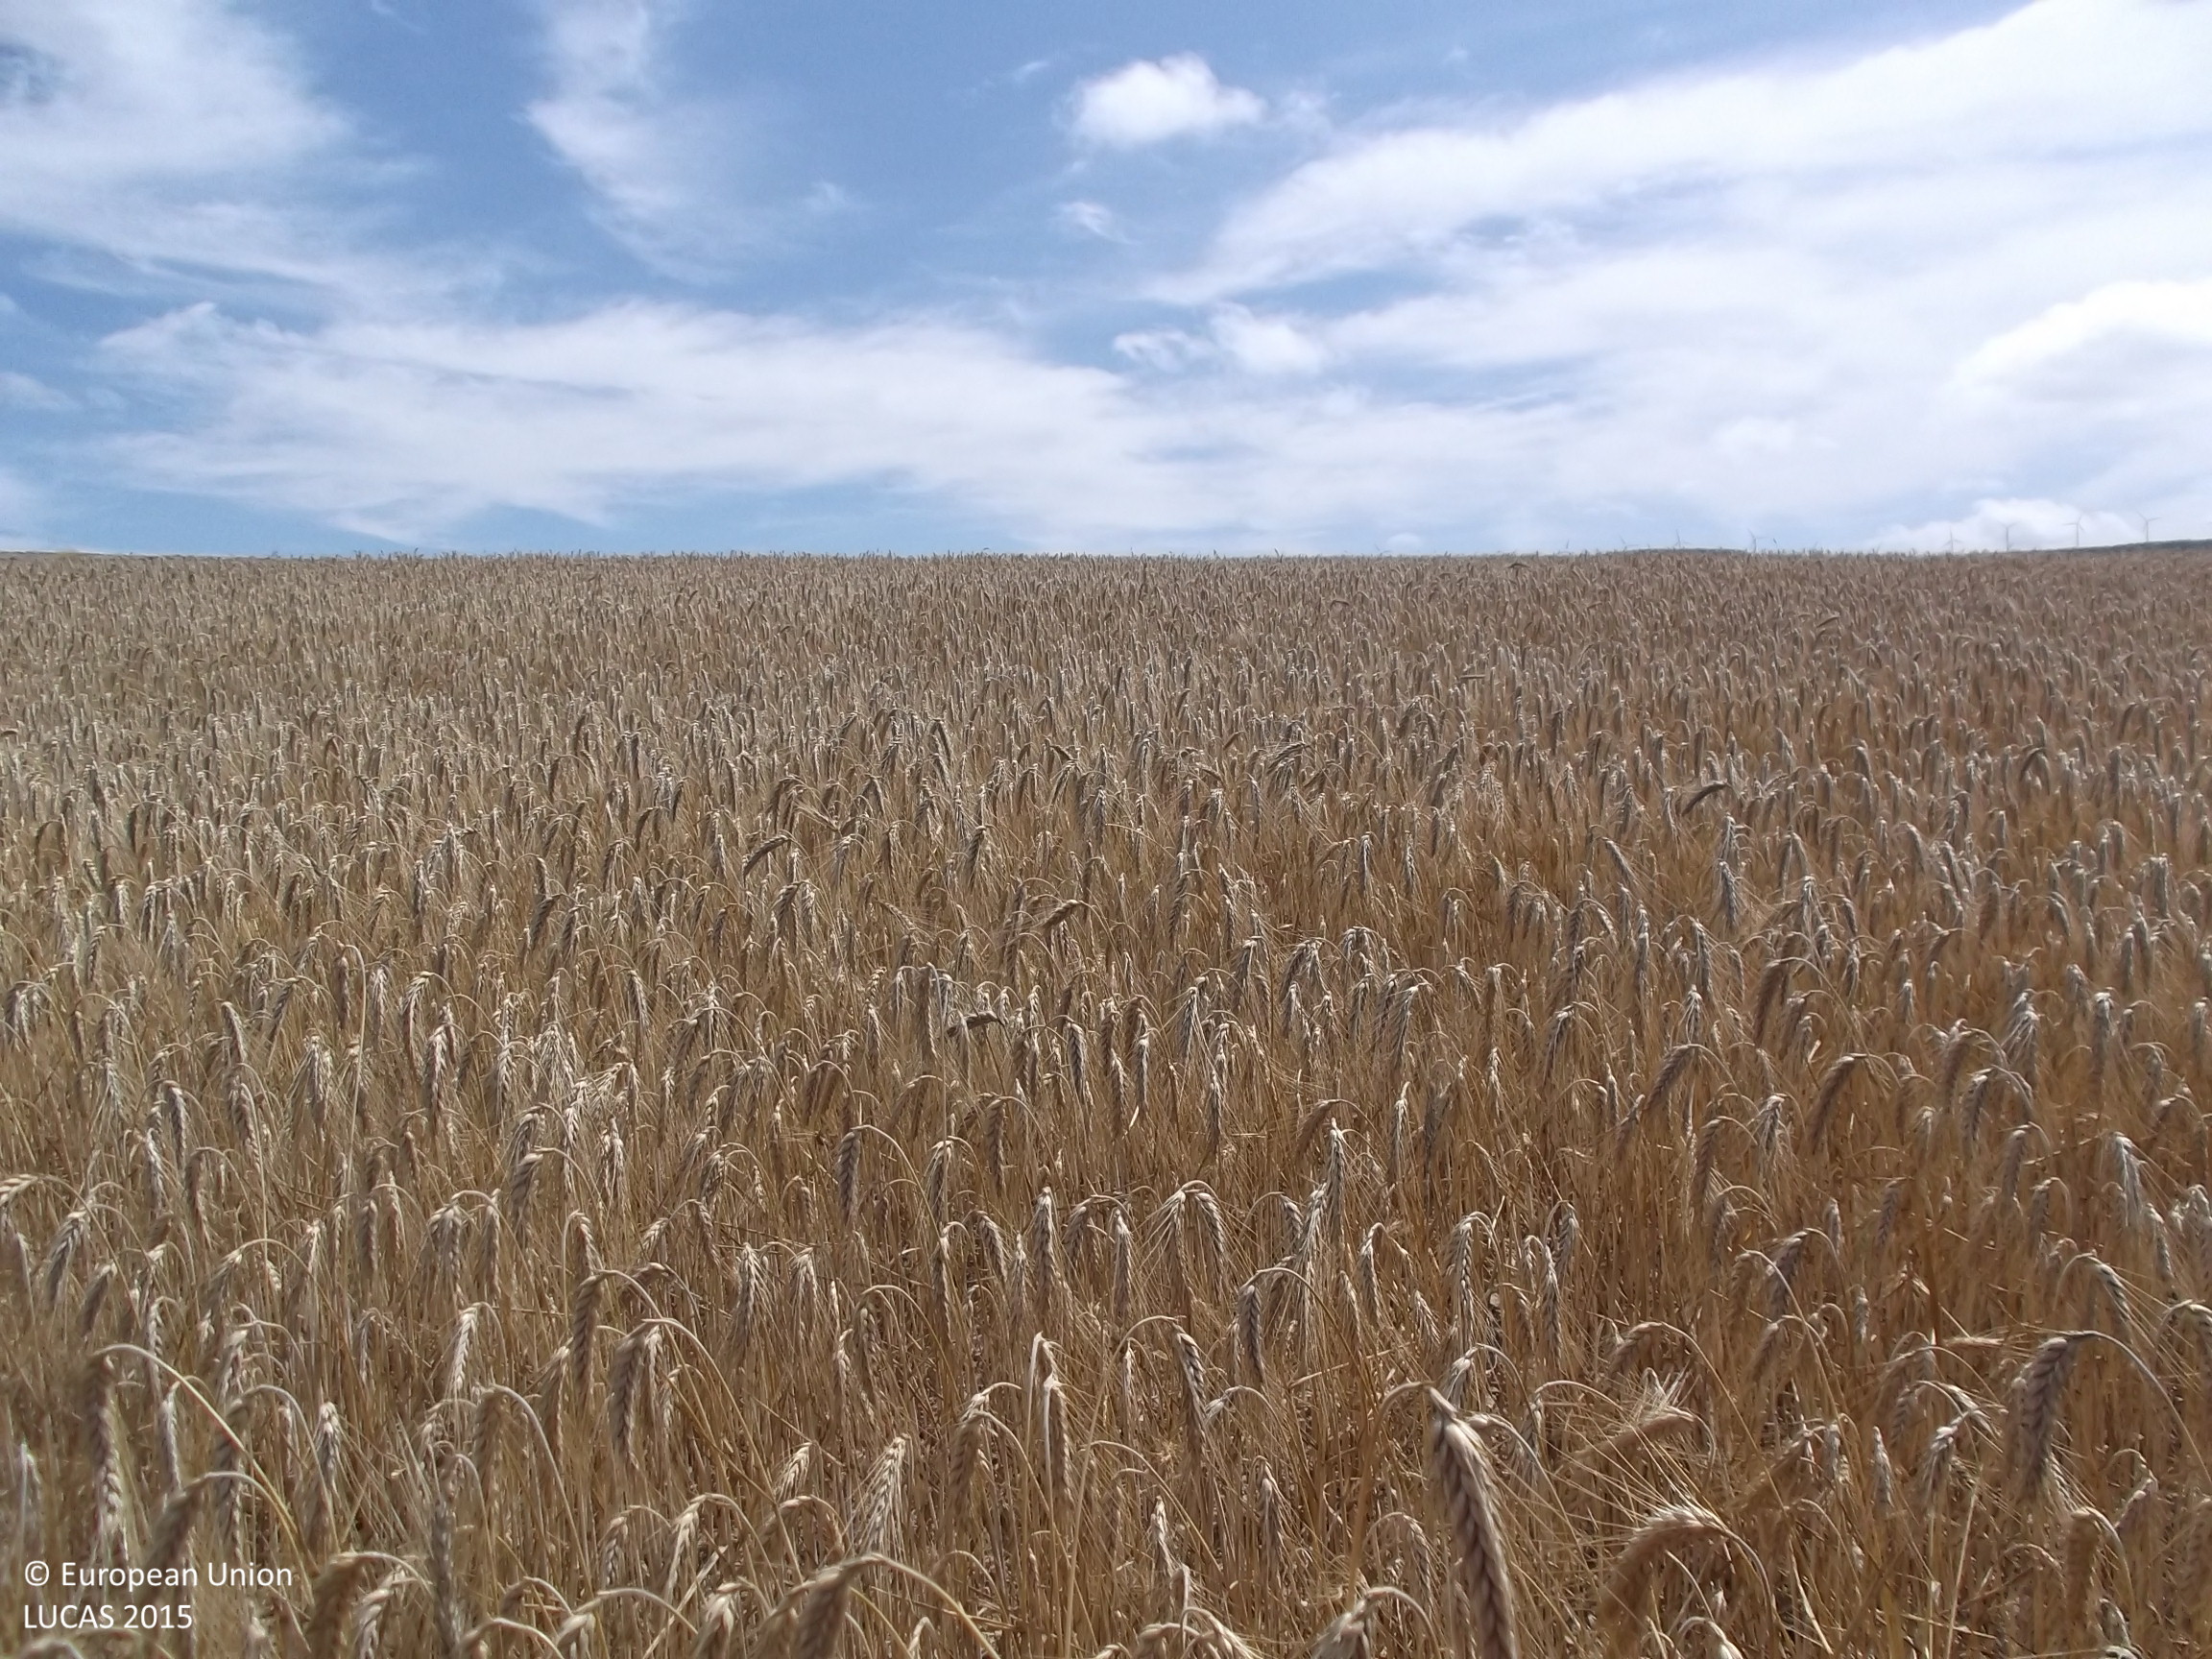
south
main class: Cropland
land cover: Rye
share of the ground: > 75 %
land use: Agriculture (excluding fallow land and kitchen gardens)
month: July
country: ES
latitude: 42.0589
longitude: -2.3532
